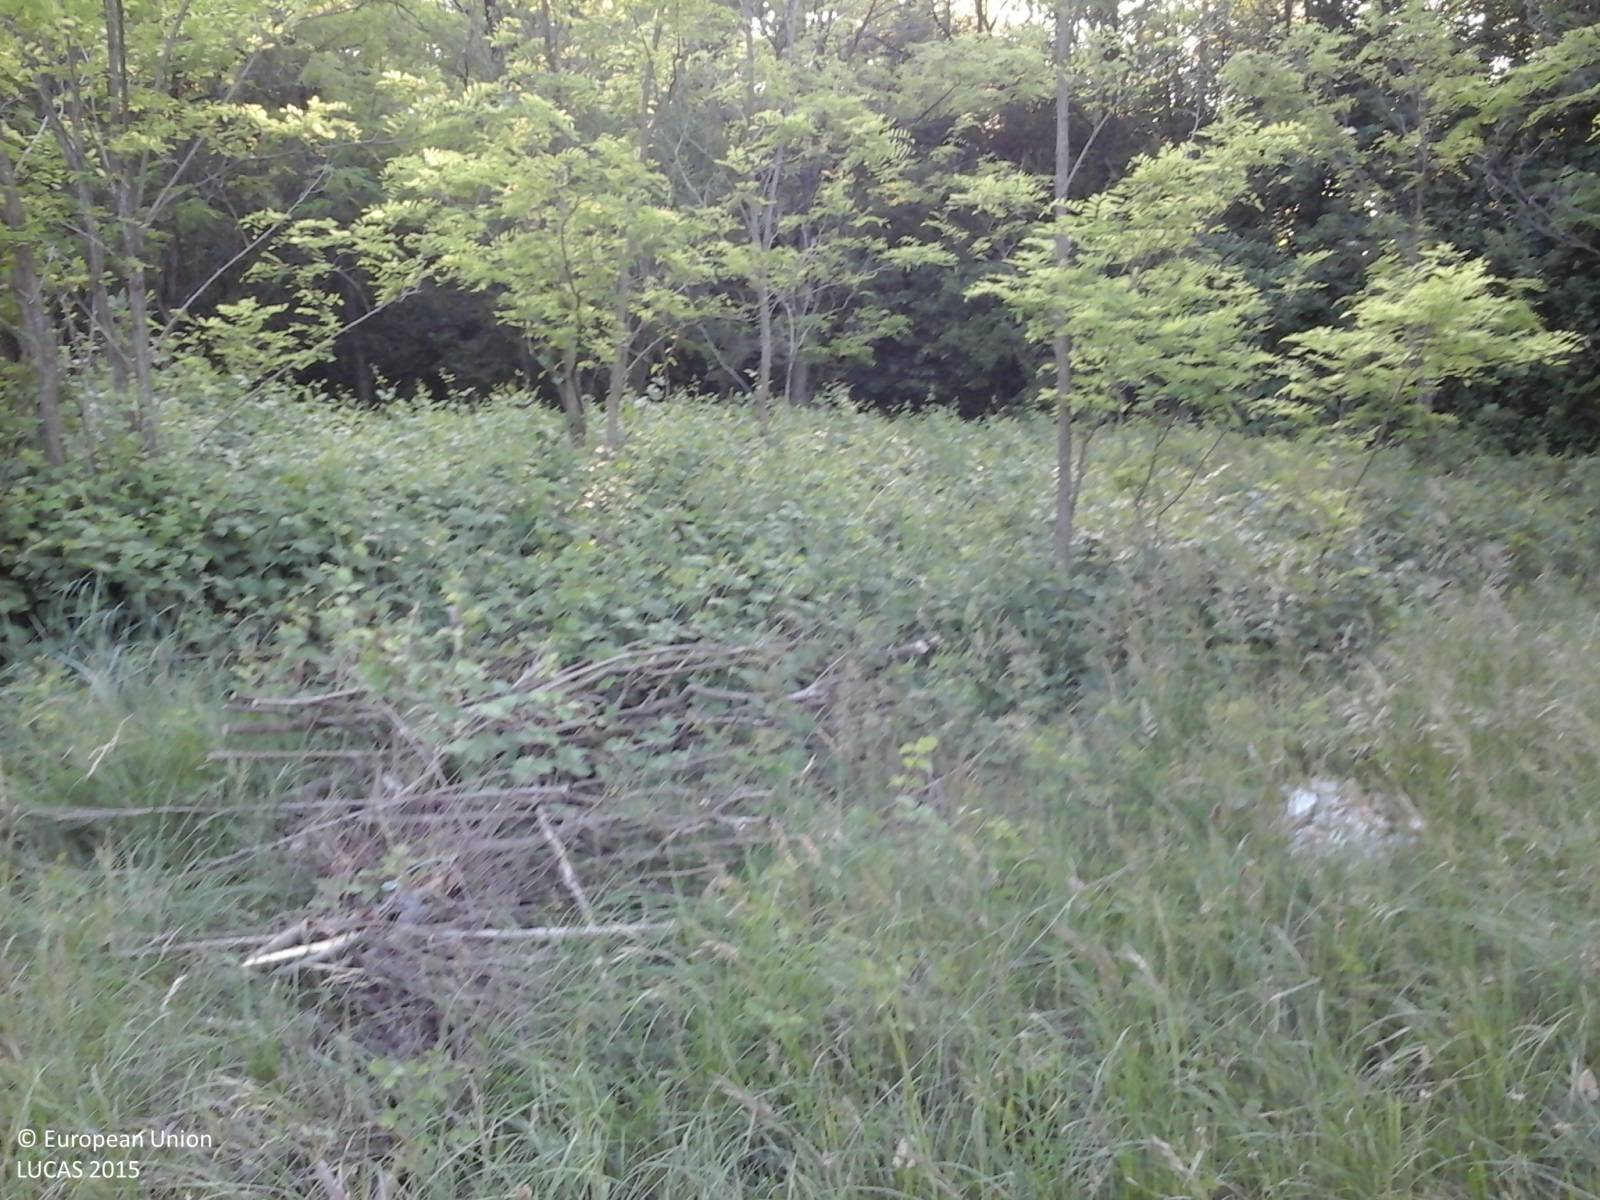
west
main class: Grassland
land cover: Grassland with sparse tree/shrub cover
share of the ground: > 75 %
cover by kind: herbaceous plants 95 %, broadleaved forest trees 5 %
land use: Semi-natural and natural areas not in use
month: May
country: IT
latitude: 45.8094
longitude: 13.4318
